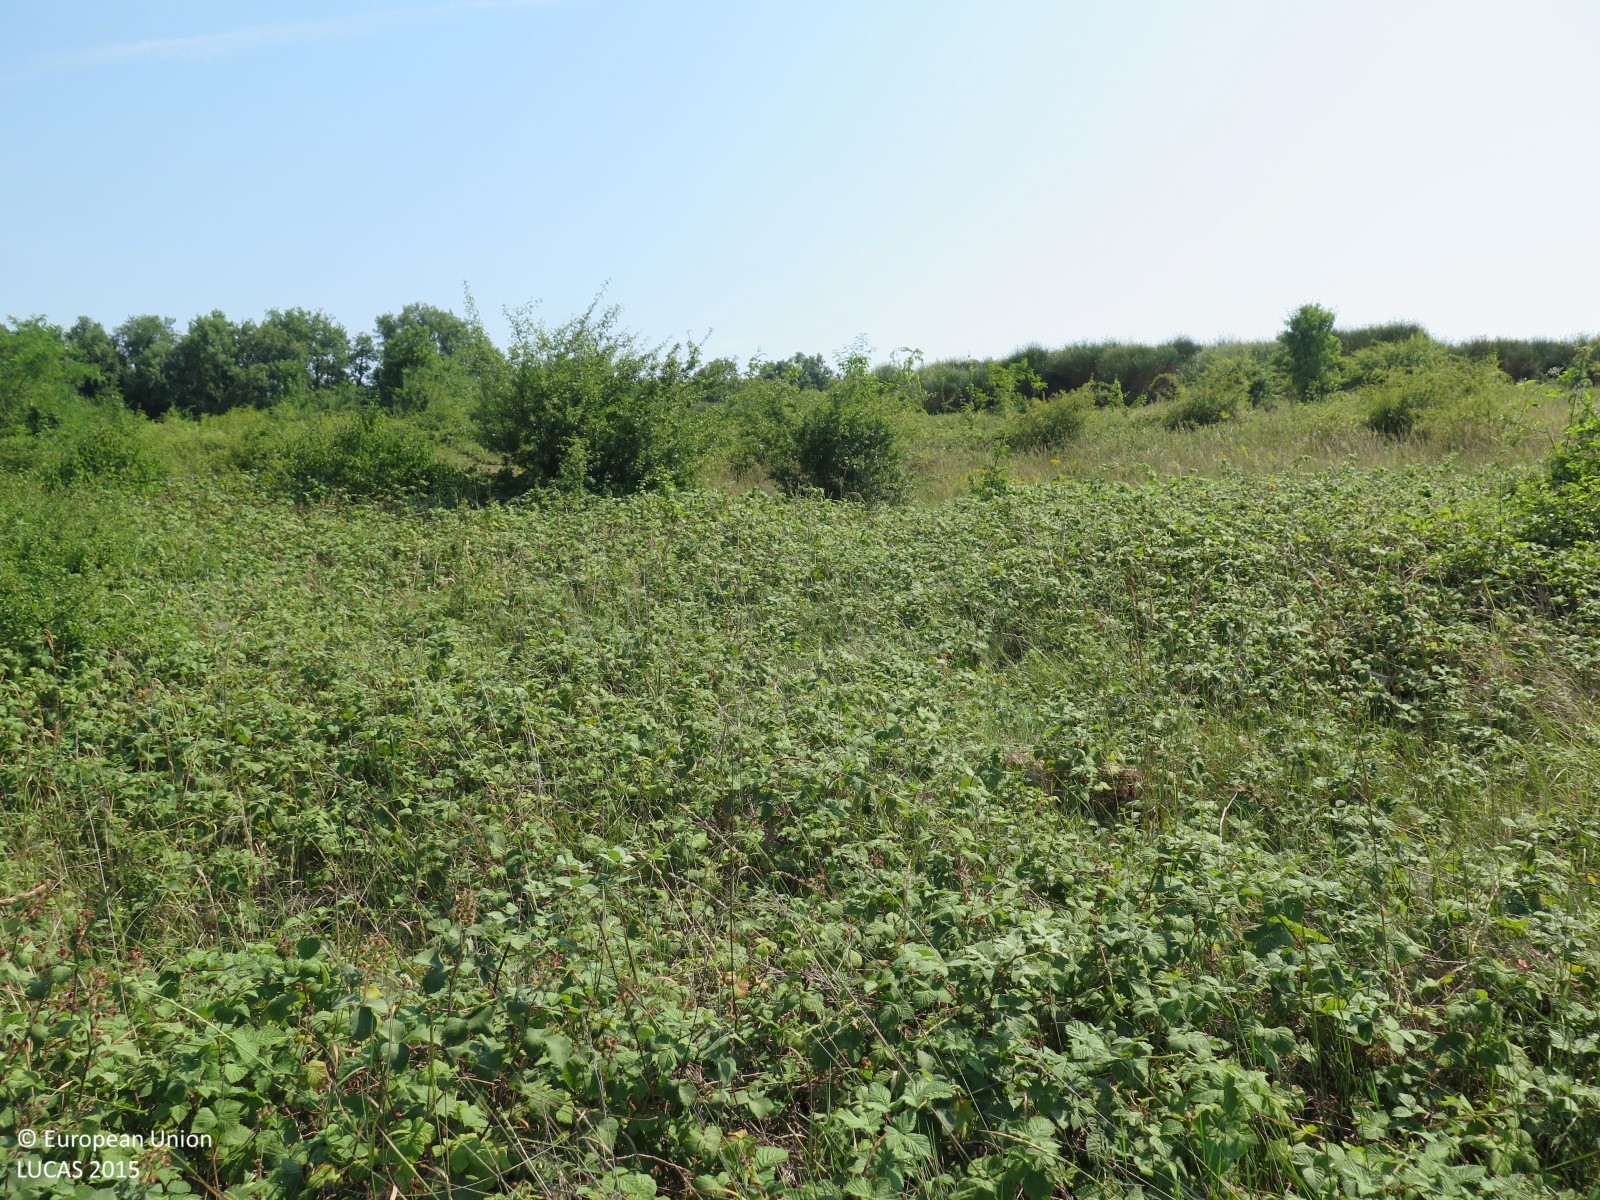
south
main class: Shrubland
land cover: Shrubland with sparse tree cover
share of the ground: > 75 %
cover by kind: shrubs 90 %, broadleaved forest trees 5 %, herbaceous plants 5 %
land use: Semi-natural and natural areas not in use
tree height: > 5 m
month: July
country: HR
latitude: 45.4820
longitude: 13.5136
